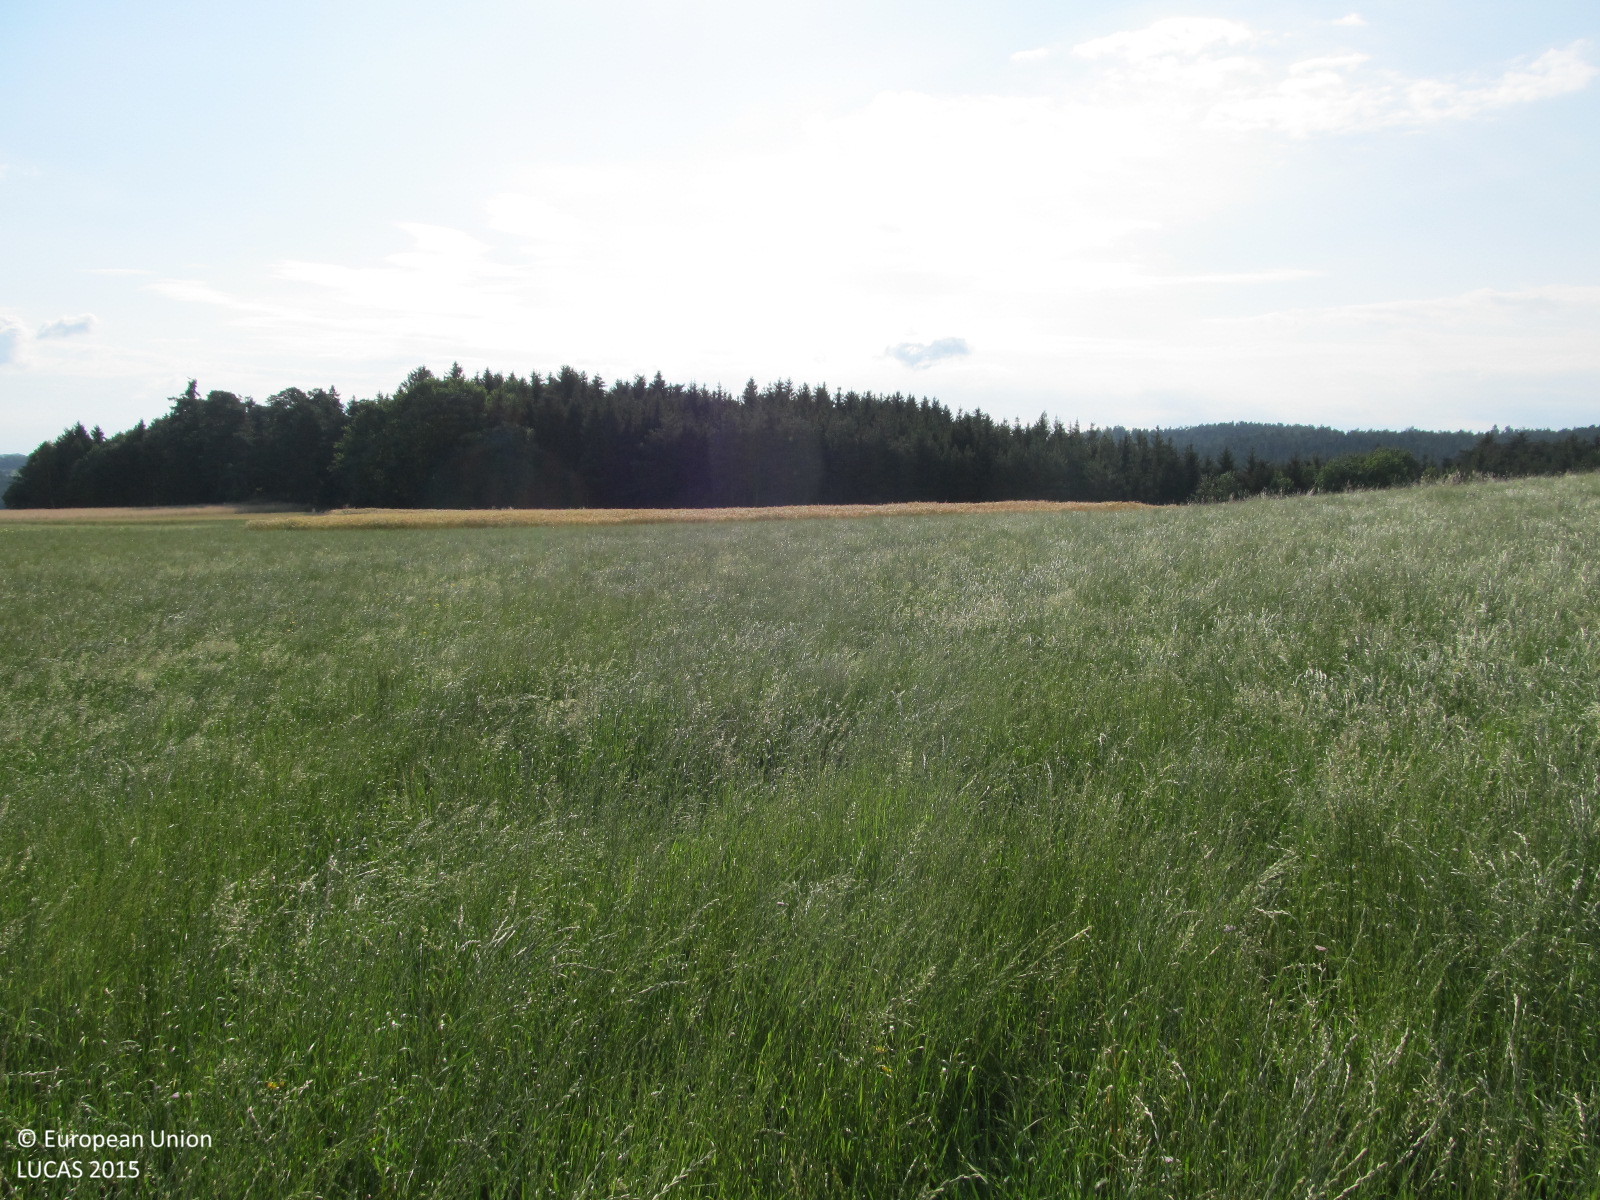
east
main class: Grassland
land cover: Grassland without tree/shrub cover
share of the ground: > 75 %
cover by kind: herbaceous plants 100 %
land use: Agriculture (excluding fallow land and kitchen gardens)
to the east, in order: Grassland without tree/shrub cover; Common wheat; Grass margins; Common wheat; Grass margins; Tracks; Spruce dominated coniferous woodland; Tracks; Spruce dominated coniferous woodland
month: July
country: AT
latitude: 48.4162
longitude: 15.3934
